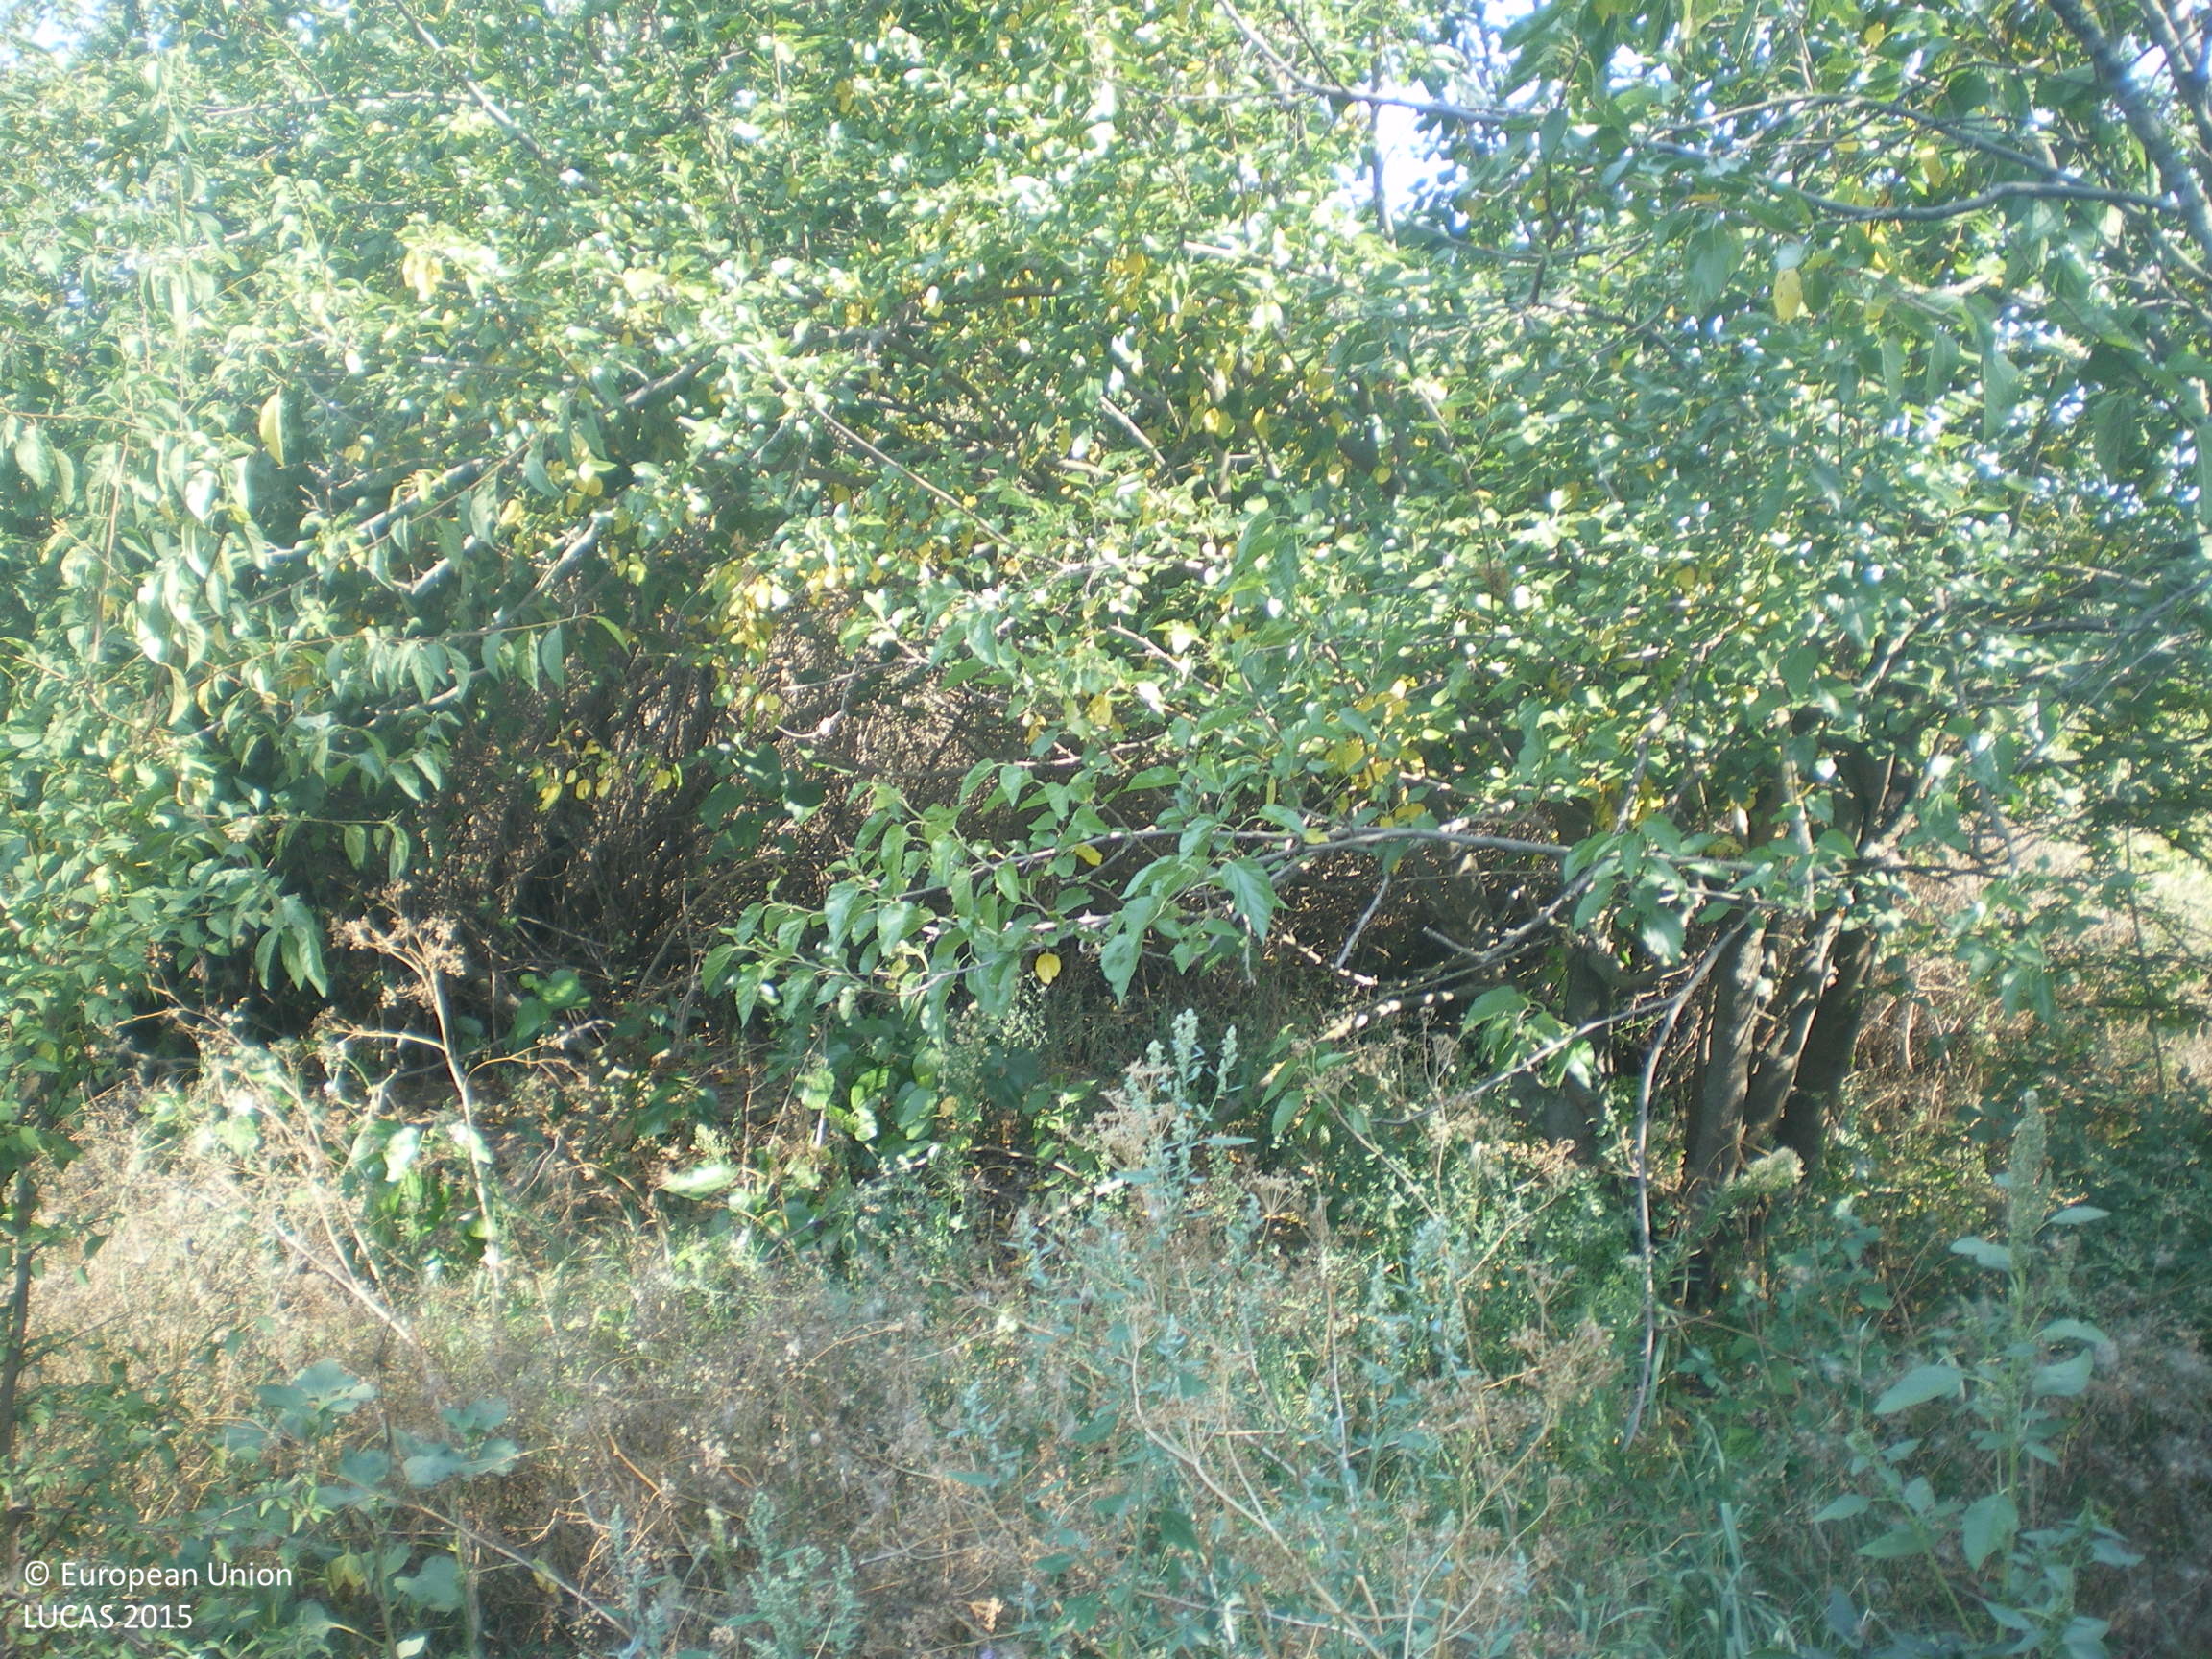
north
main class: Woodland
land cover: Broadleaved woodland
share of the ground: > 75 %
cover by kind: broadleaved forest trees 80 %, shrubs 10 %, herbaceous plants 10 %
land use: Residential
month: August
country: BG
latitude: 42.3362
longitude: 25.7171
